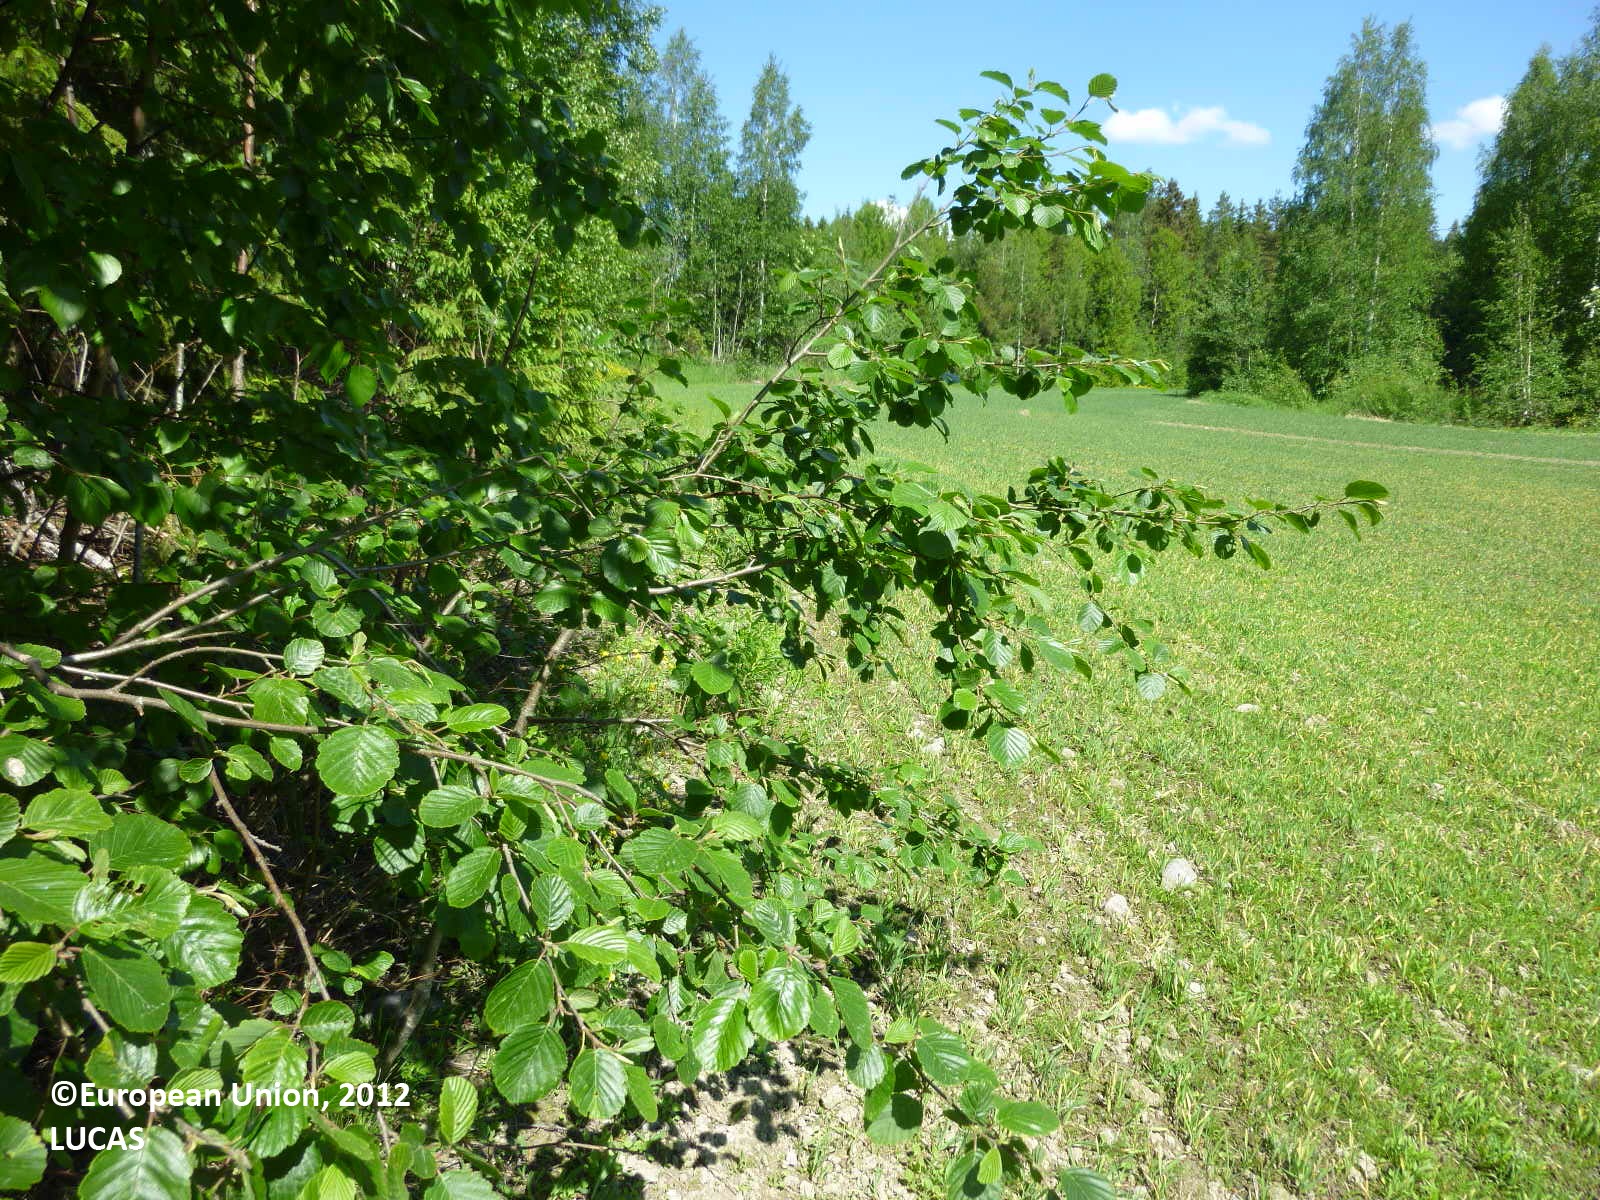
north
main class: Cropland
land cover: Barley
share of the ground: 25 - 50 %
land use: Agriculture (excluding fallow land and kitchen gardens)
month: June
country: FI
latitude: 61.4860
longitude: 22.7044
